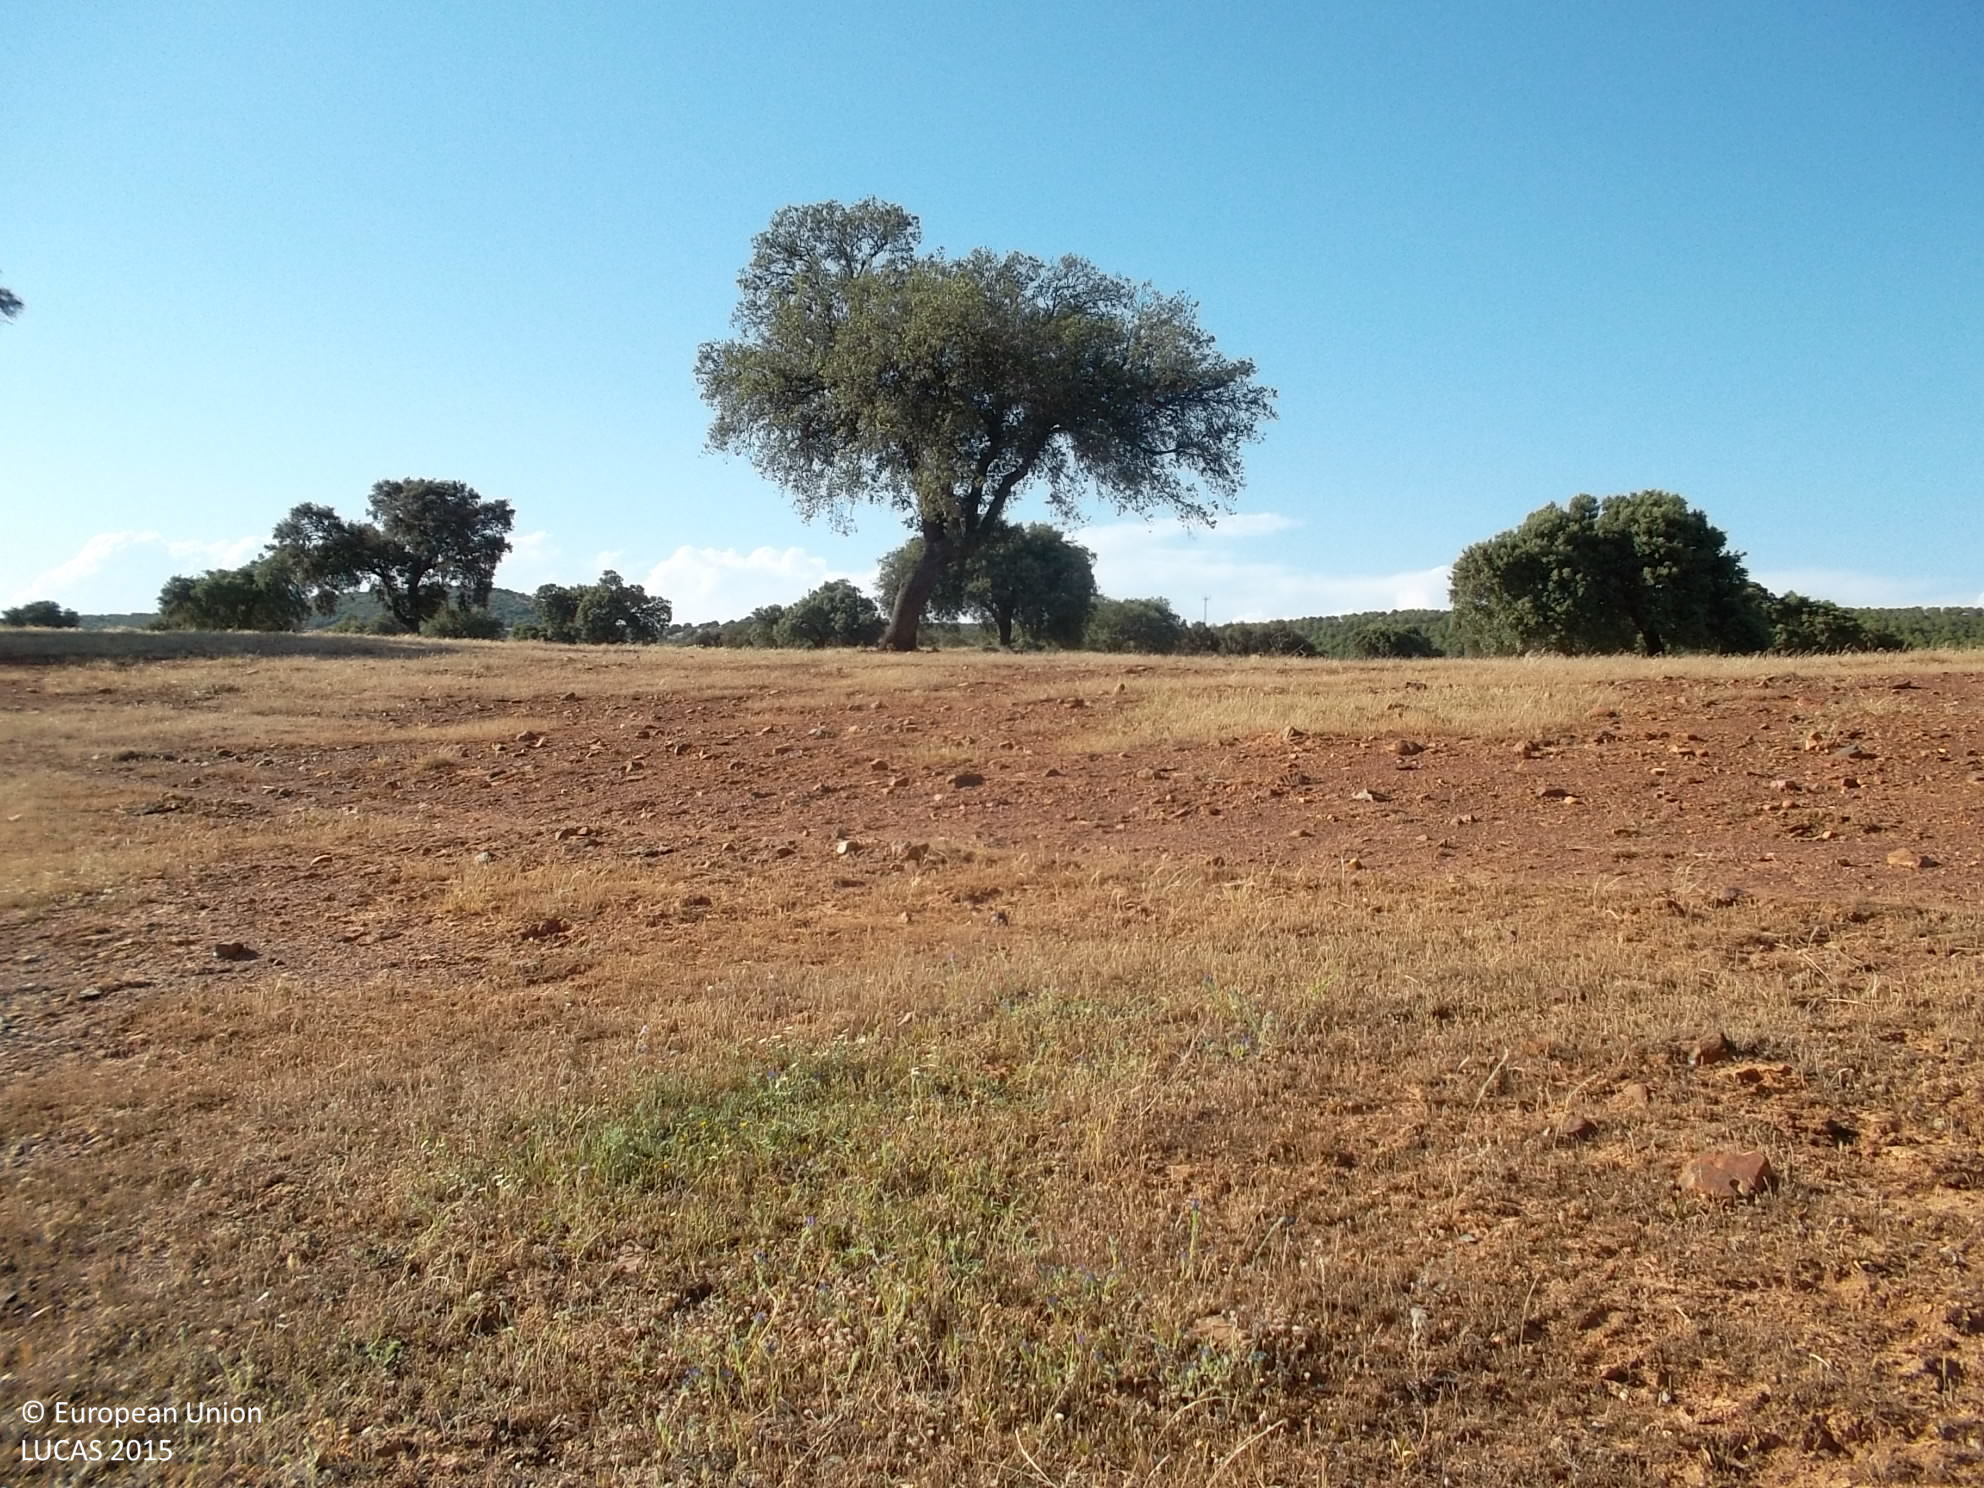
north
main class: Grassland
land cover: Grassland with sparse tree/shrub cover
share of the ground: > 75 %
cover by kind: herbaceous plants 95 %, broadleaved forest trees 5 %
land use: Agriculture (excluding fallow land and kitchen gardens)
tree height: > 5 m
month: May
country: ES
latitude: 38.8280
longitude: -4.7853
